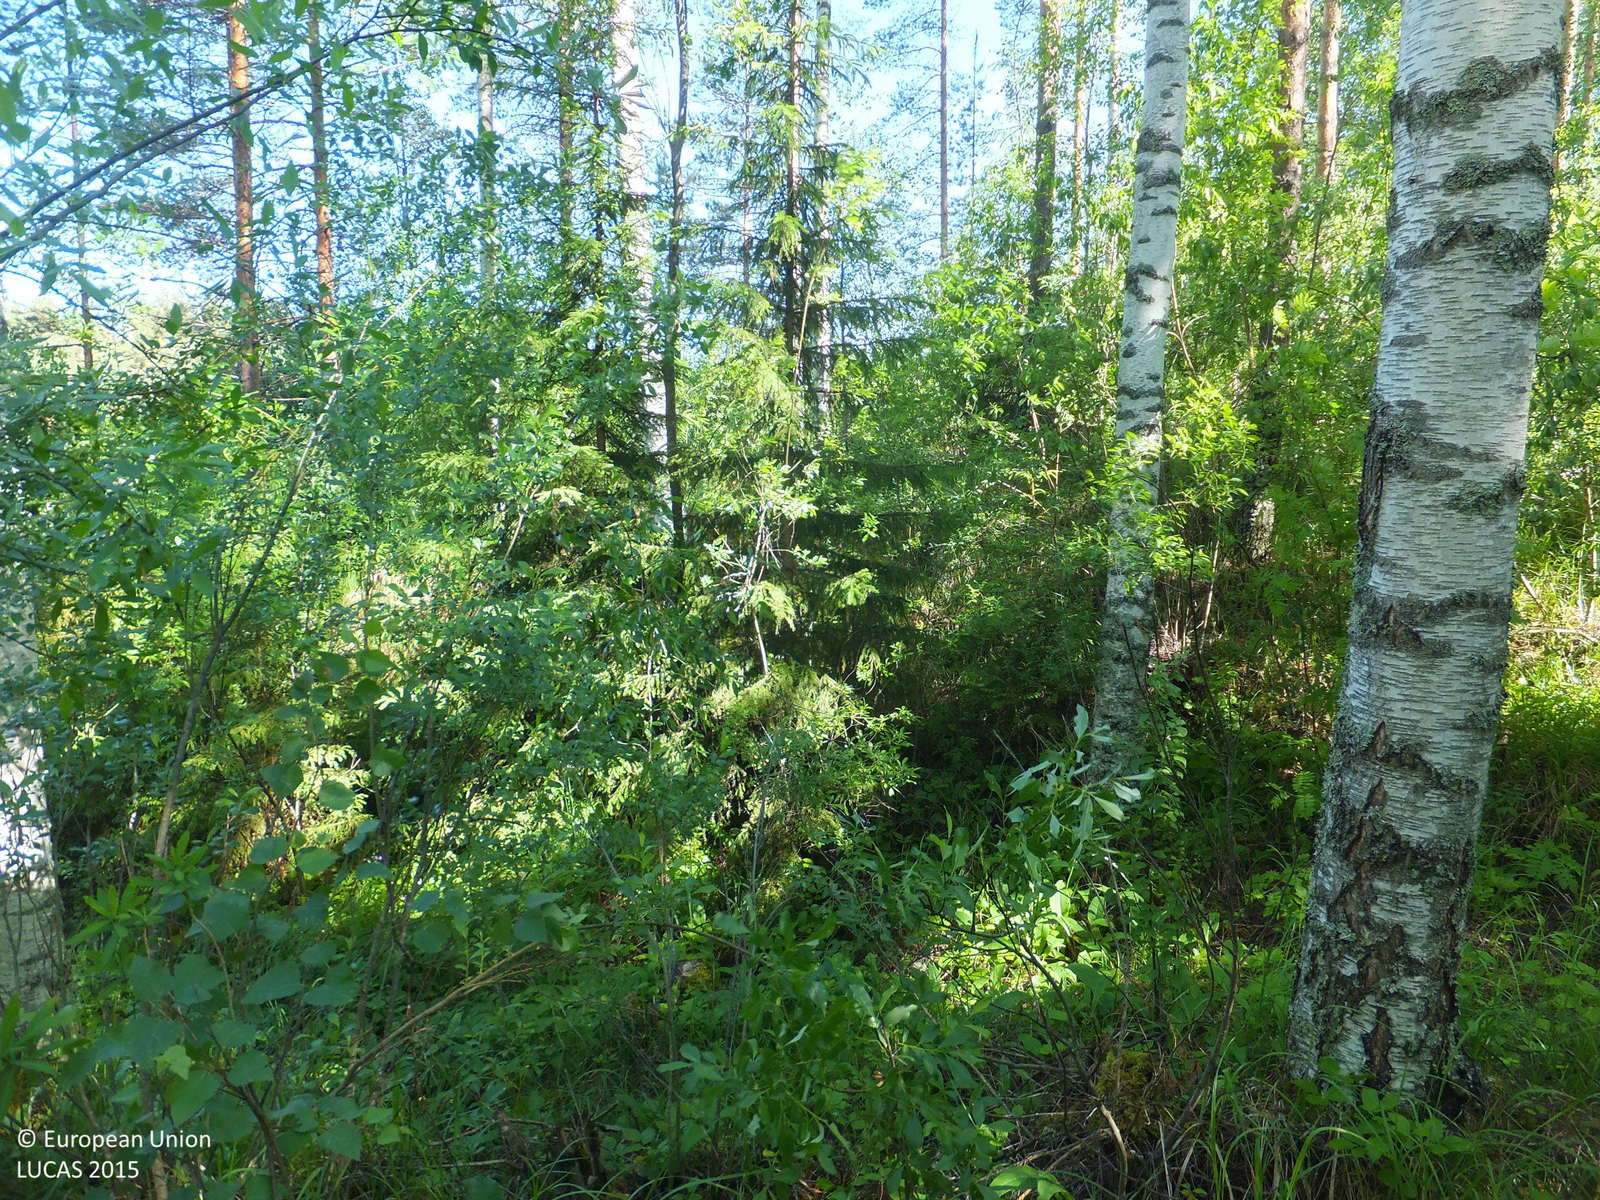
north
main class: Woodland
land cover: Other mixed woodland
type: boreal forest
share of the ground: > 75 %
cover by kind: coniferous forest trees 40 %, broadleaved forest trees 35 %, herbaceous plants 20 %, shrubs 5 %
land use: Forestry
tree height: > 5 m
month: July
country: FI
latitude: 63.1320
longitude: 23.9768
